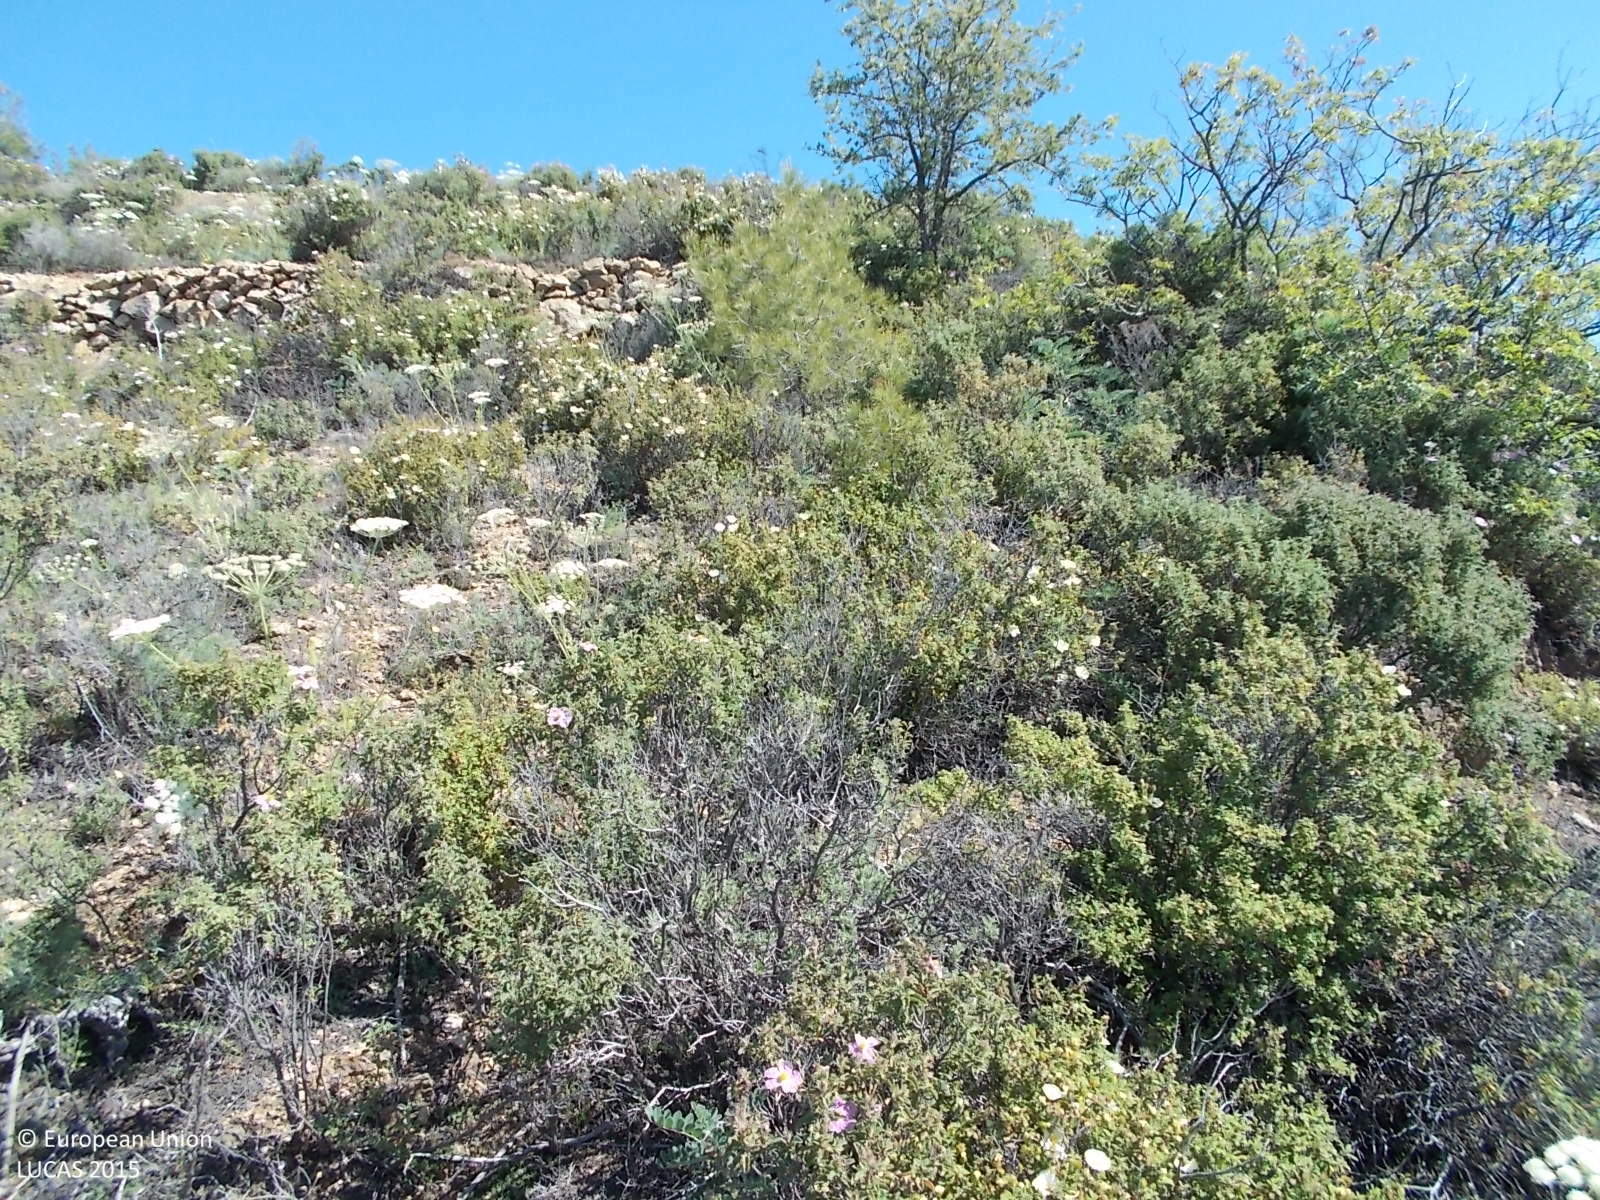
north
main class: Shrubland
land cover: Shrubland with sparse tree cover
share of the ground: > 75 %
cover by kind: shrubs 95 %, broadleaved forest trees 5 %
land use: Semi-natural and natural areas not in use
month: May
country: CY
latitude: 34.8636
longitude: 33.0209
